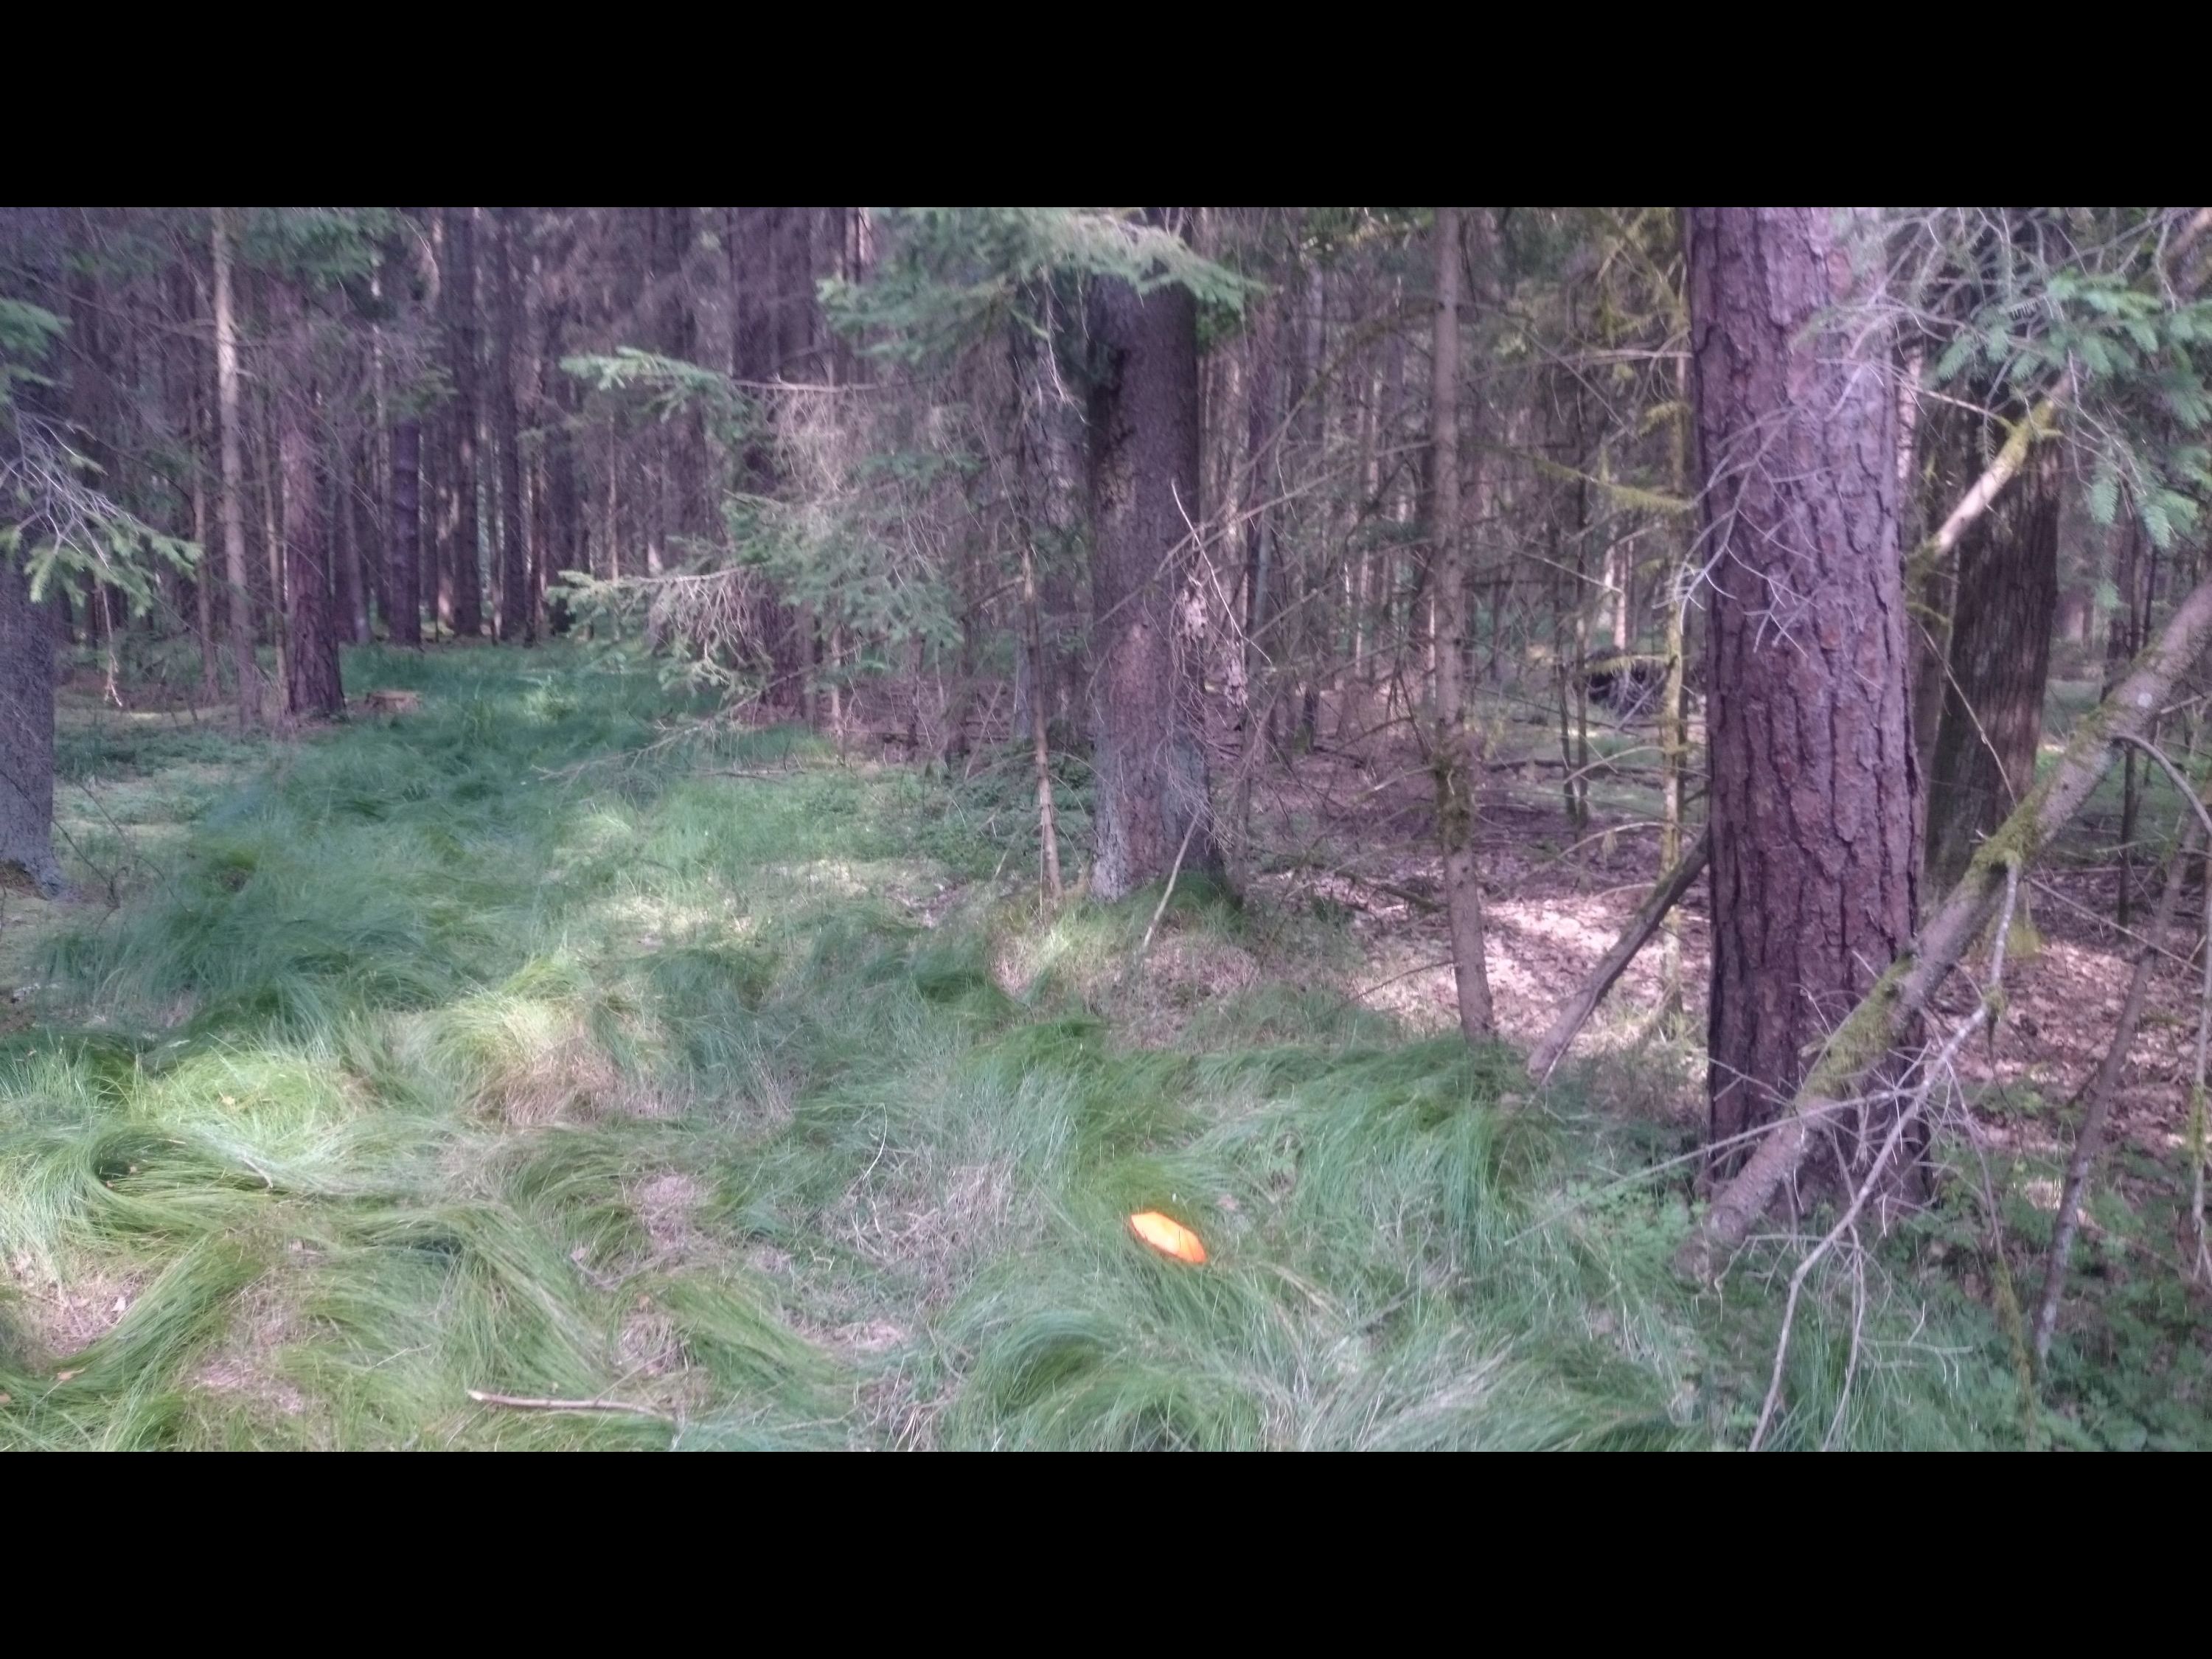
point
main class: Woodland
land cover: Spruce dominated coniferous woodland
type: hemiboreal forest and nemoral coniferous forest and mixed broadleaved-coniferous forest
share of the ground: > 75 %
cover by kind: coniferous forest trees 70 %, herbaceous plants 15 %, lichens and mosses 10 %, shrubs 5 %
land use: Forestry
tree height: > 5 m
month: July
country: AT
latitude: 47.1009
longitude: 16.0491
